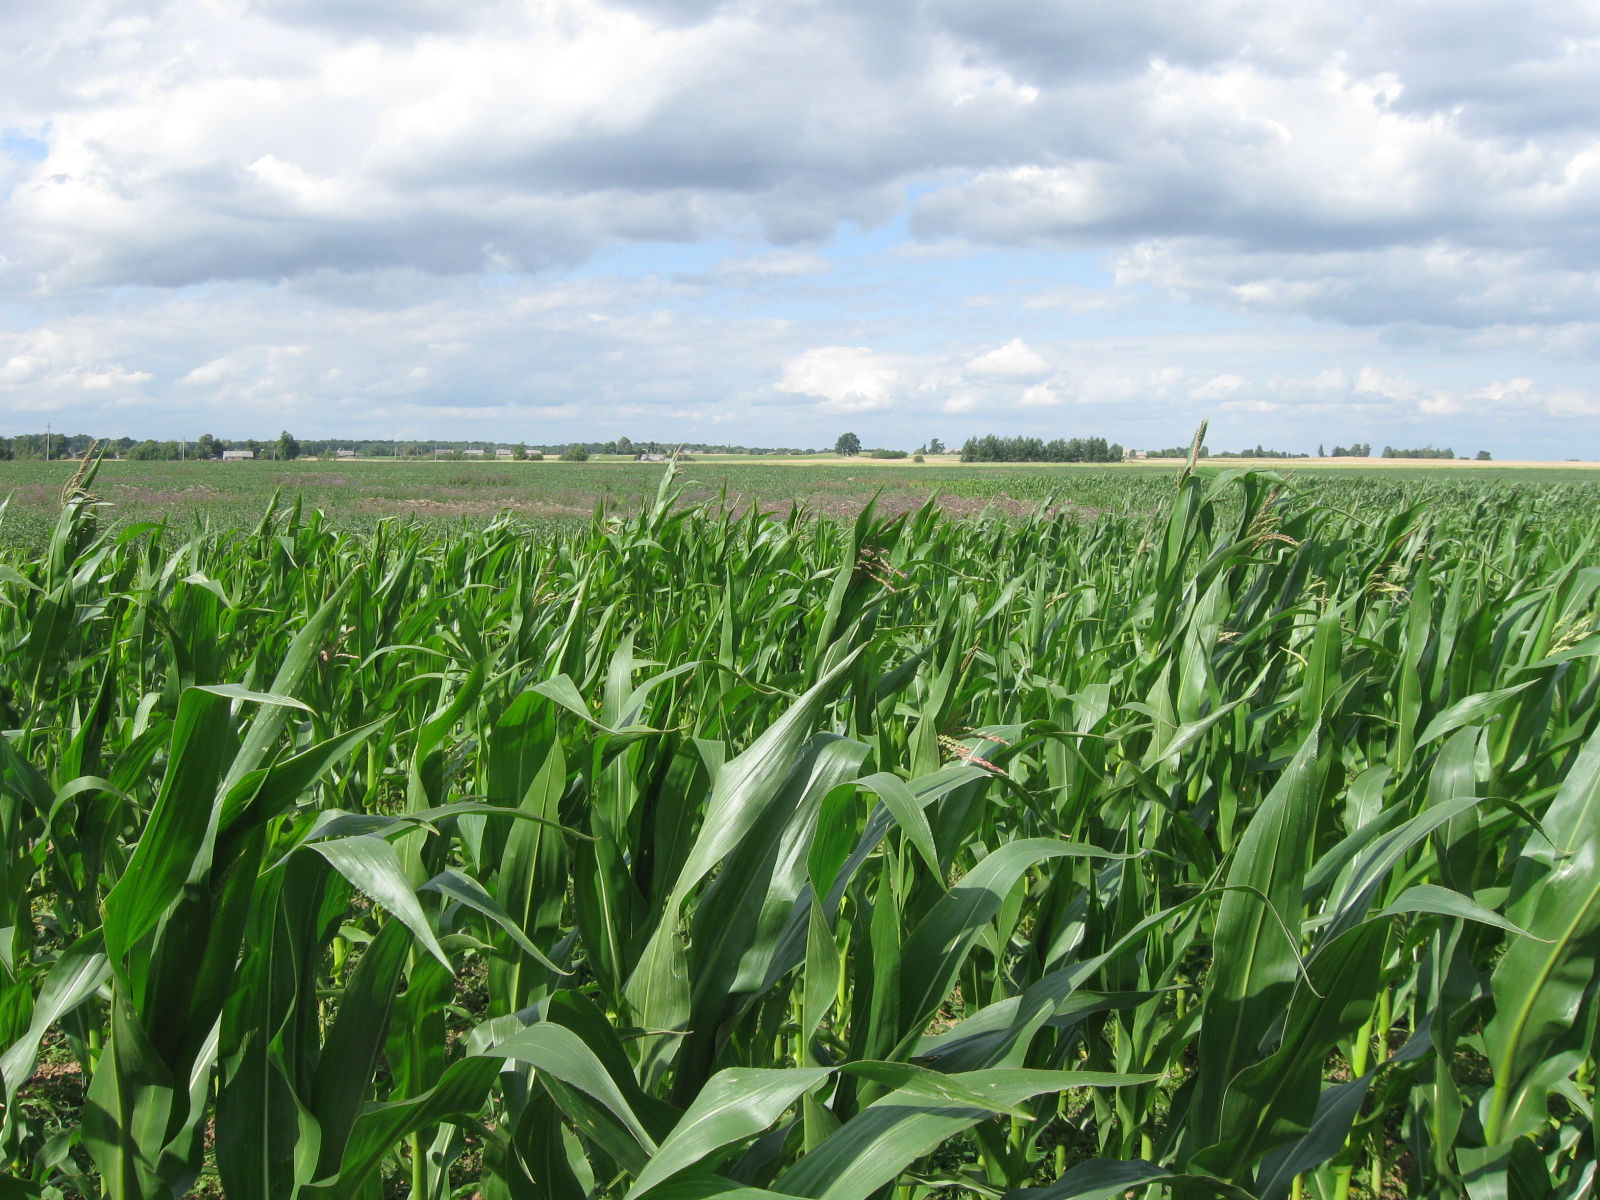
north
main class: Cropland
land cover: Maize
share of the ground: > 75 %
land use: Agriculture (excluding fallow land and kitchen gardens)
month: July
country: LT
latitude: 54.3790
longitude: 23.4605
